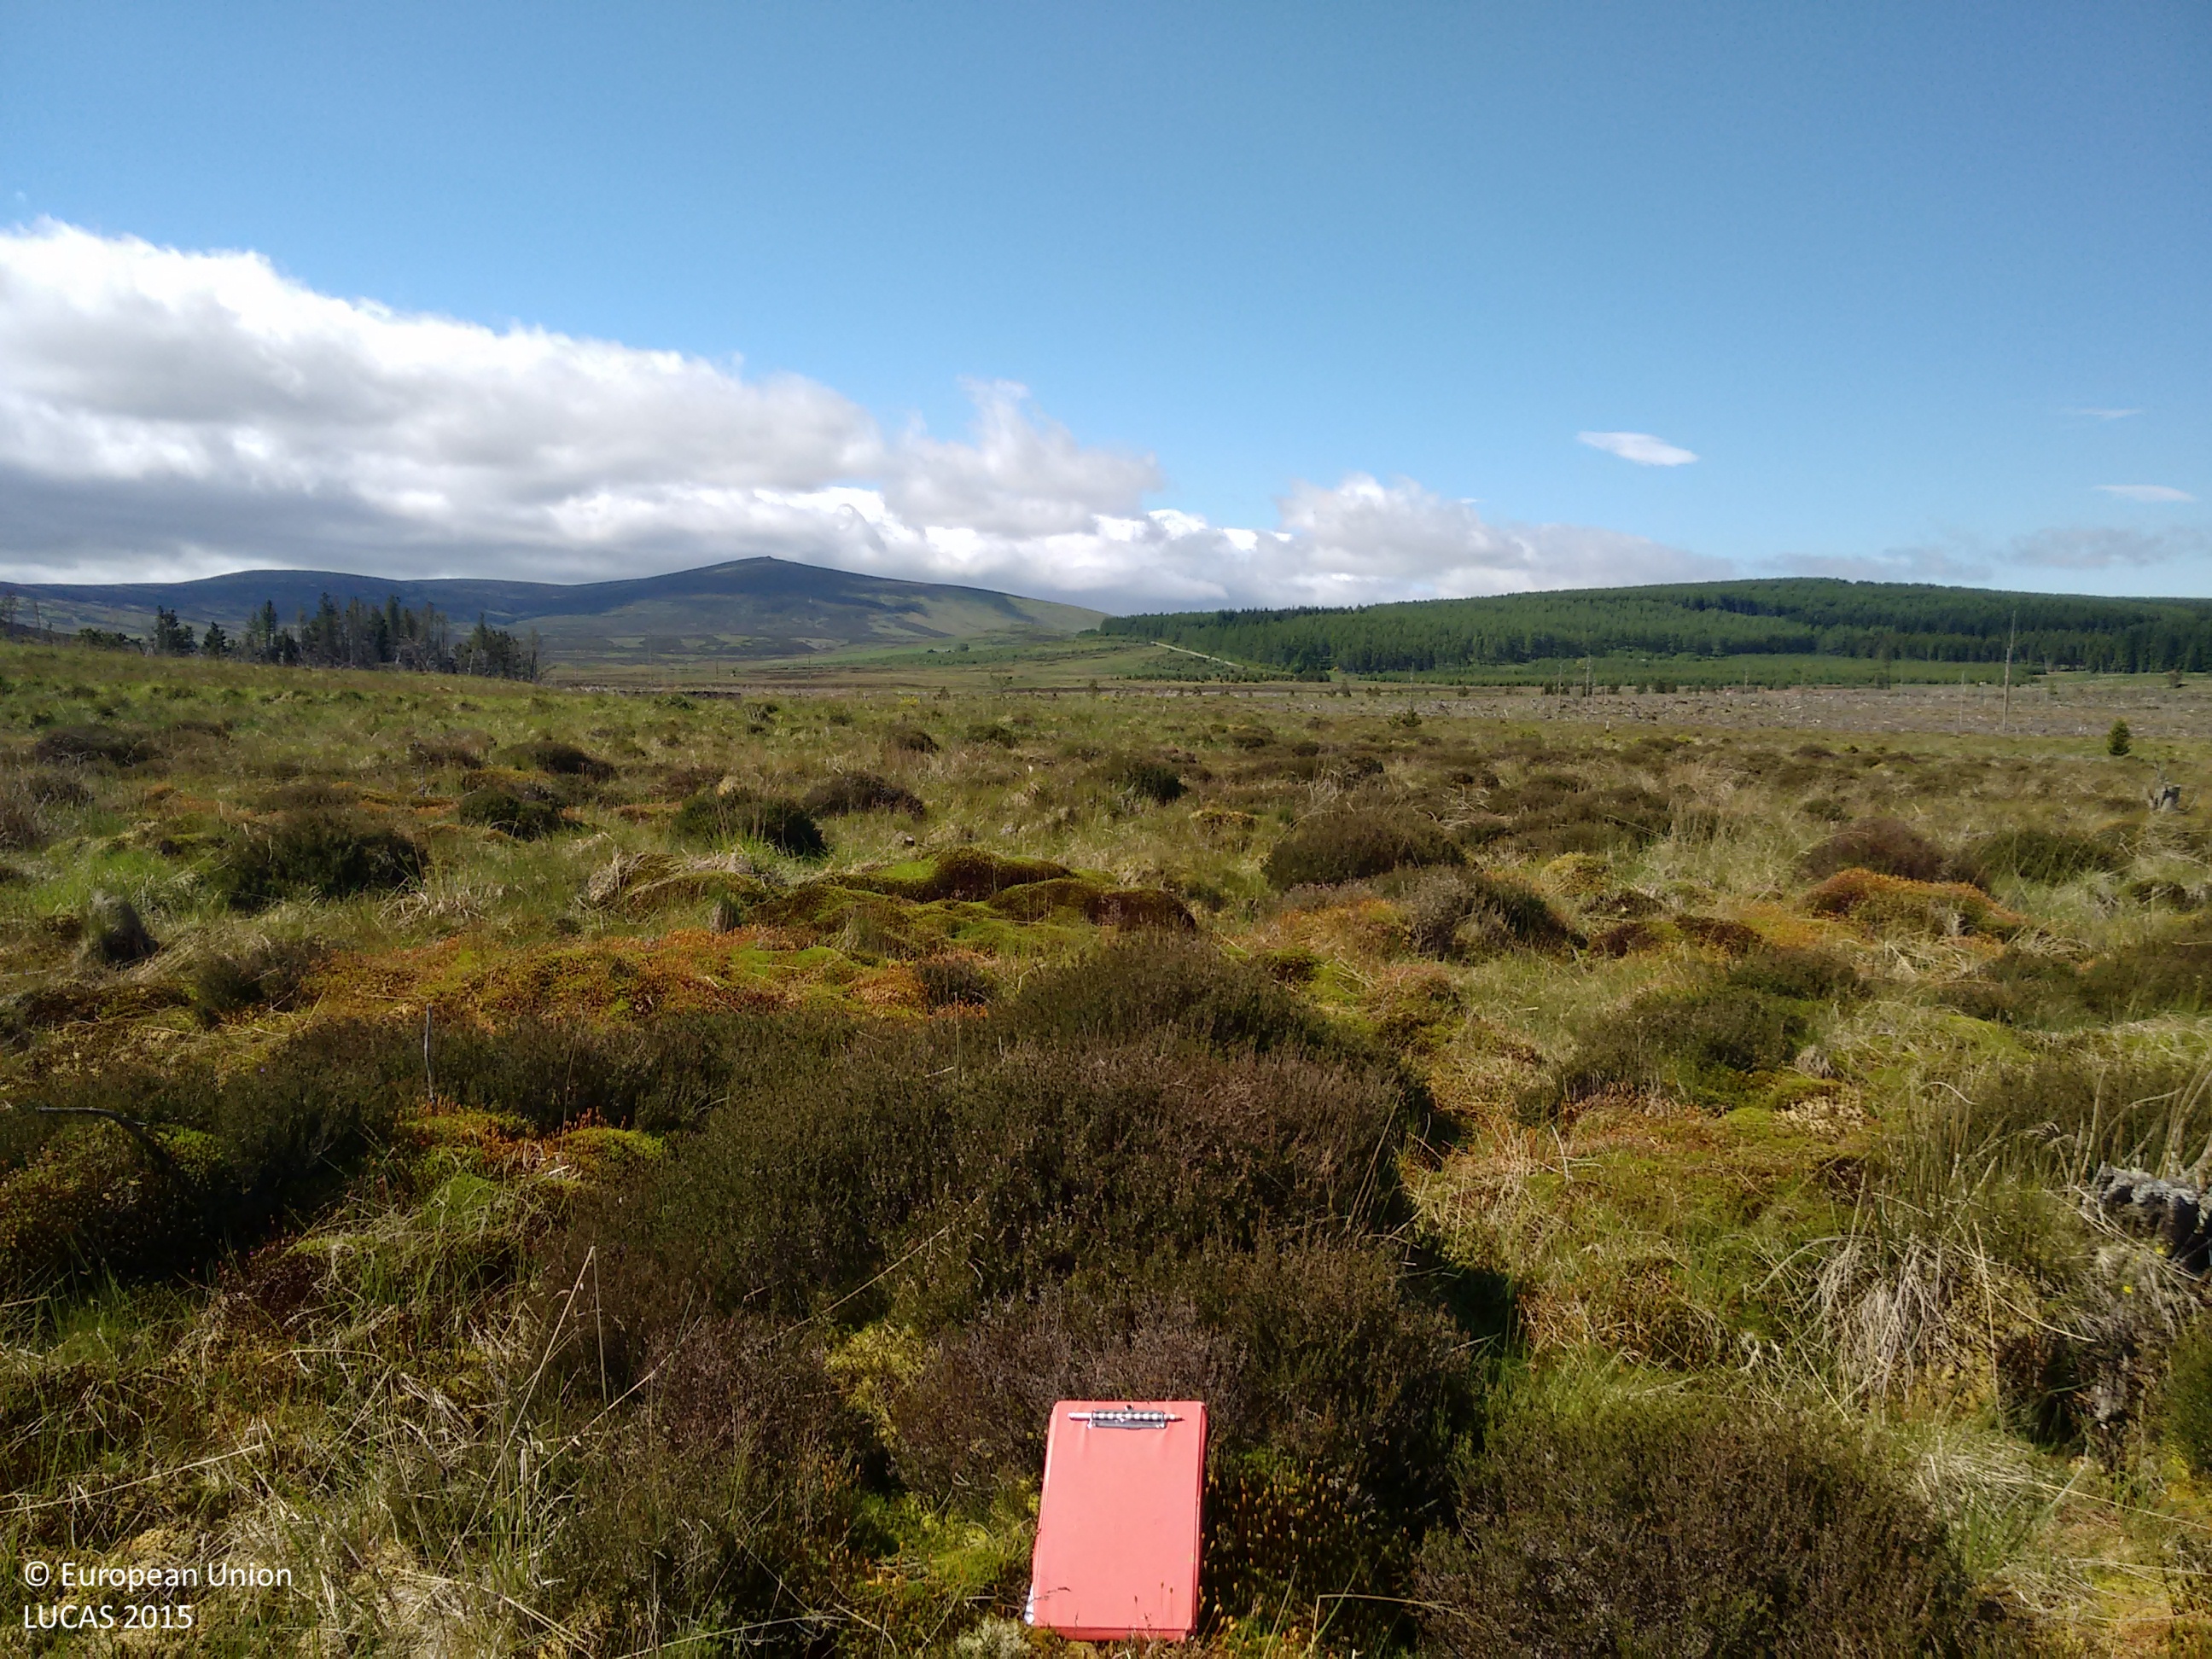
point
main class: Shrubland
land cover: Shrubland without tree cover
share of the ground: > 75 %
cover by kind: herbaceous plants 60 %, shrubs 30 %, lichens and mosses 10 %
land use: Semi-natural and natural areas not in use
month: June
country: GB
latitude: 57.3354
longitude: -2.9355
